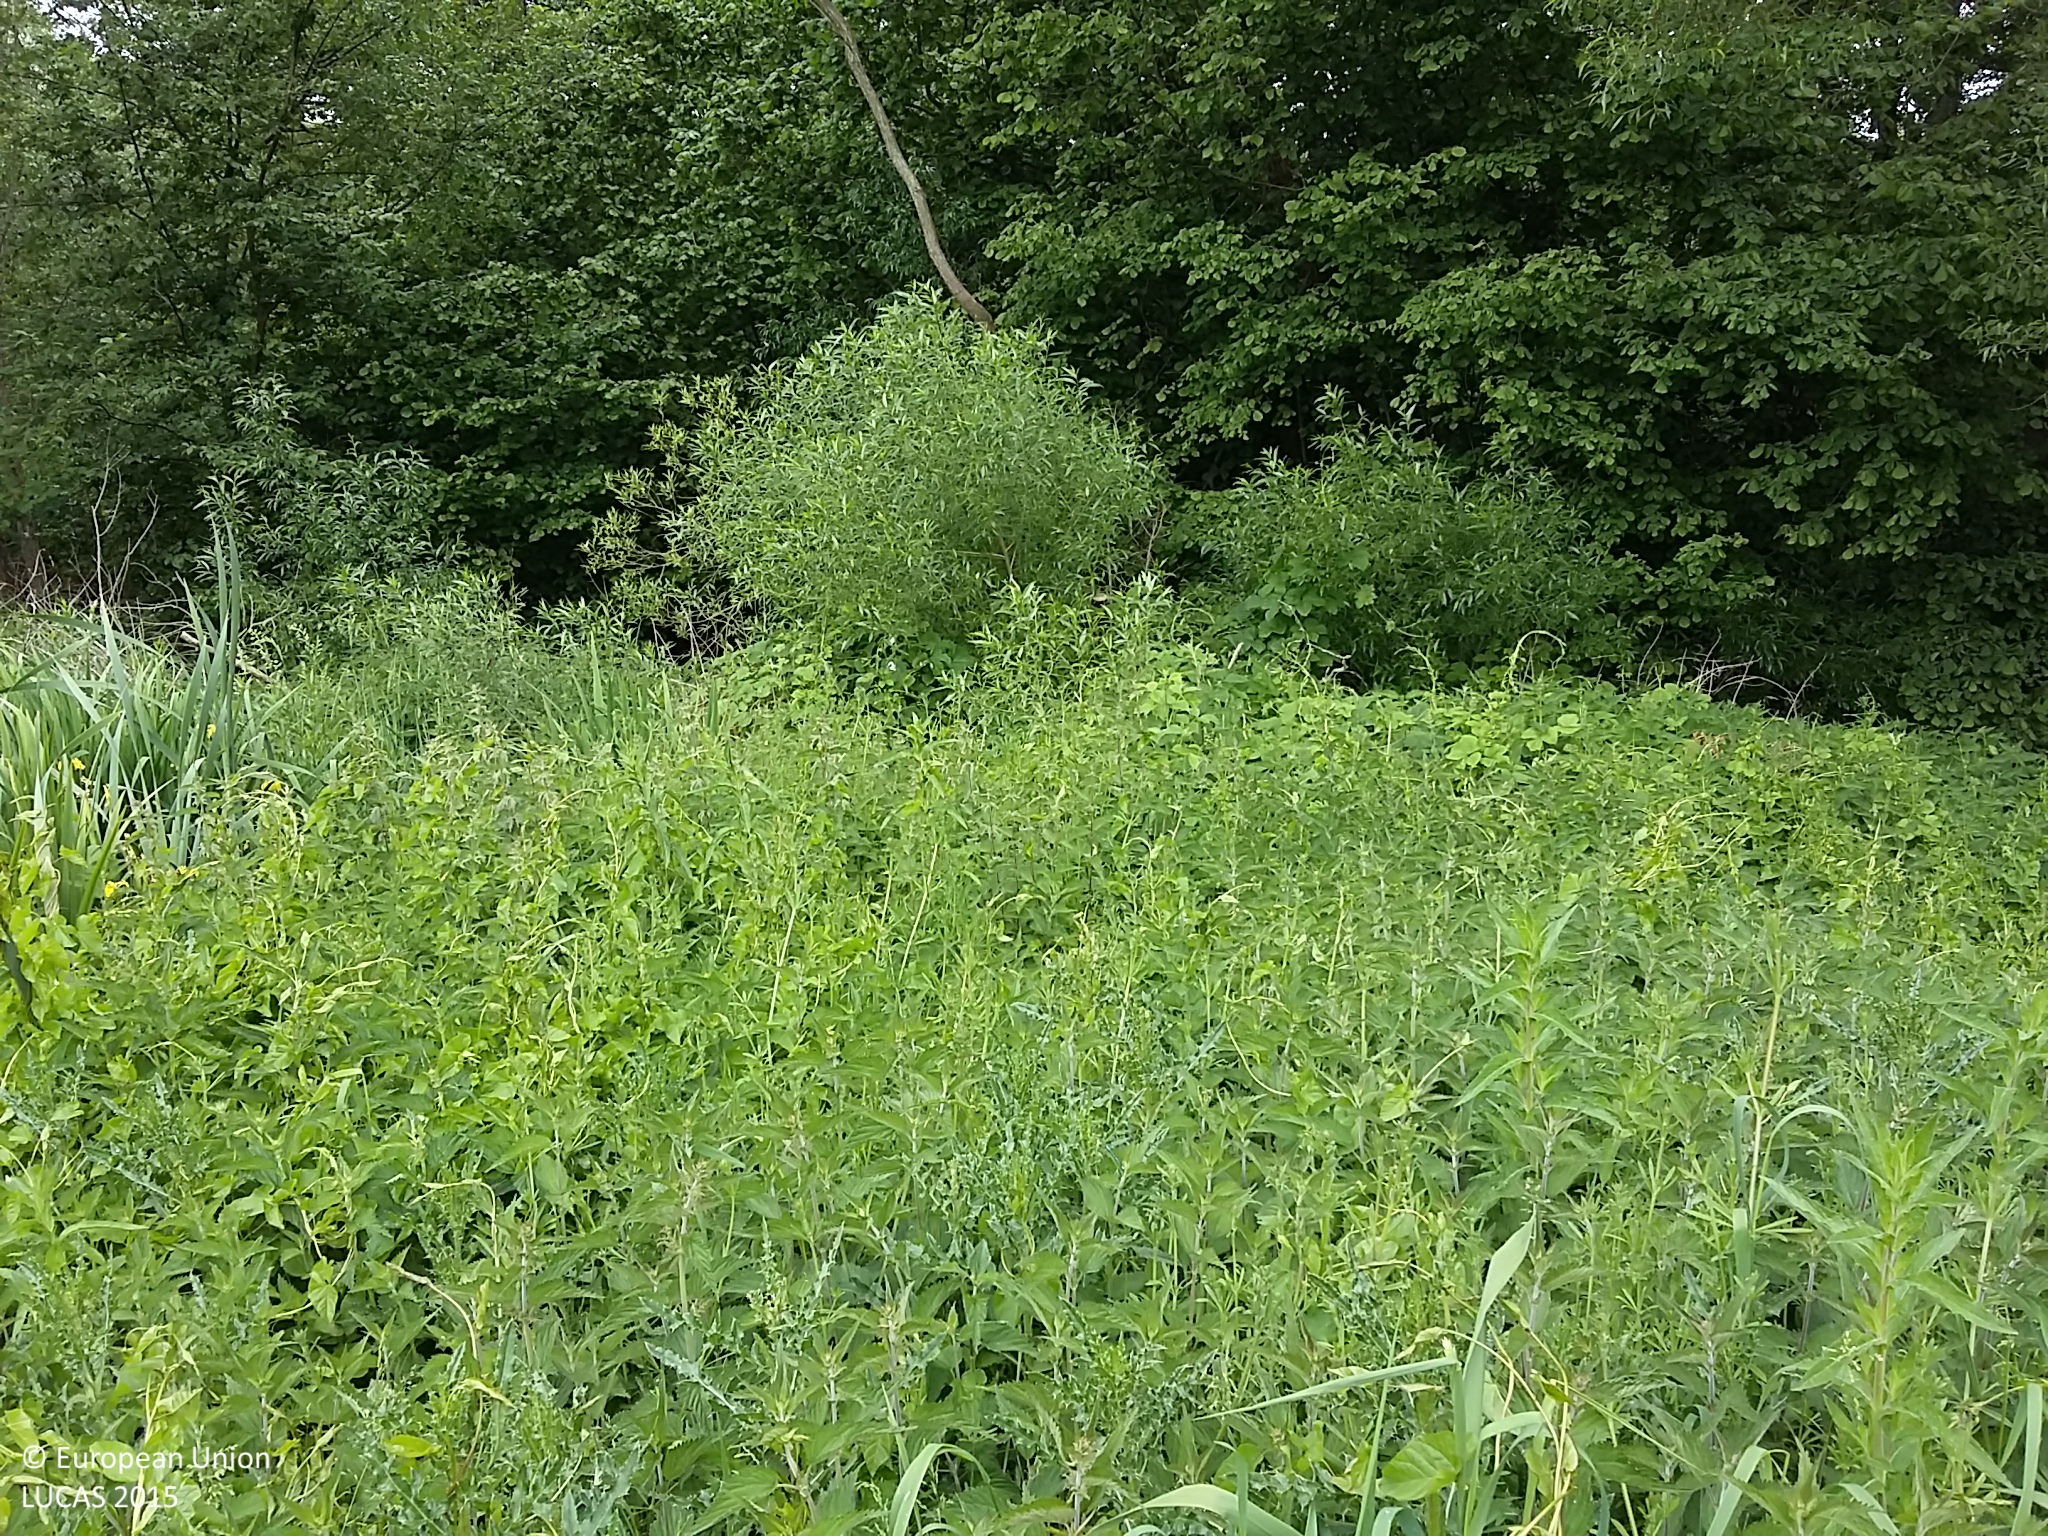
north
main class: Grassland
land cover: Spontaneously vegetated surfaces
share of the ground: > 75 %
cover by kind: herbaceous plants 100 %
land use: Semi-natural and natural areas not in use
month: June
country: DK
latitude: 55.2689
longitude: 10.7391
